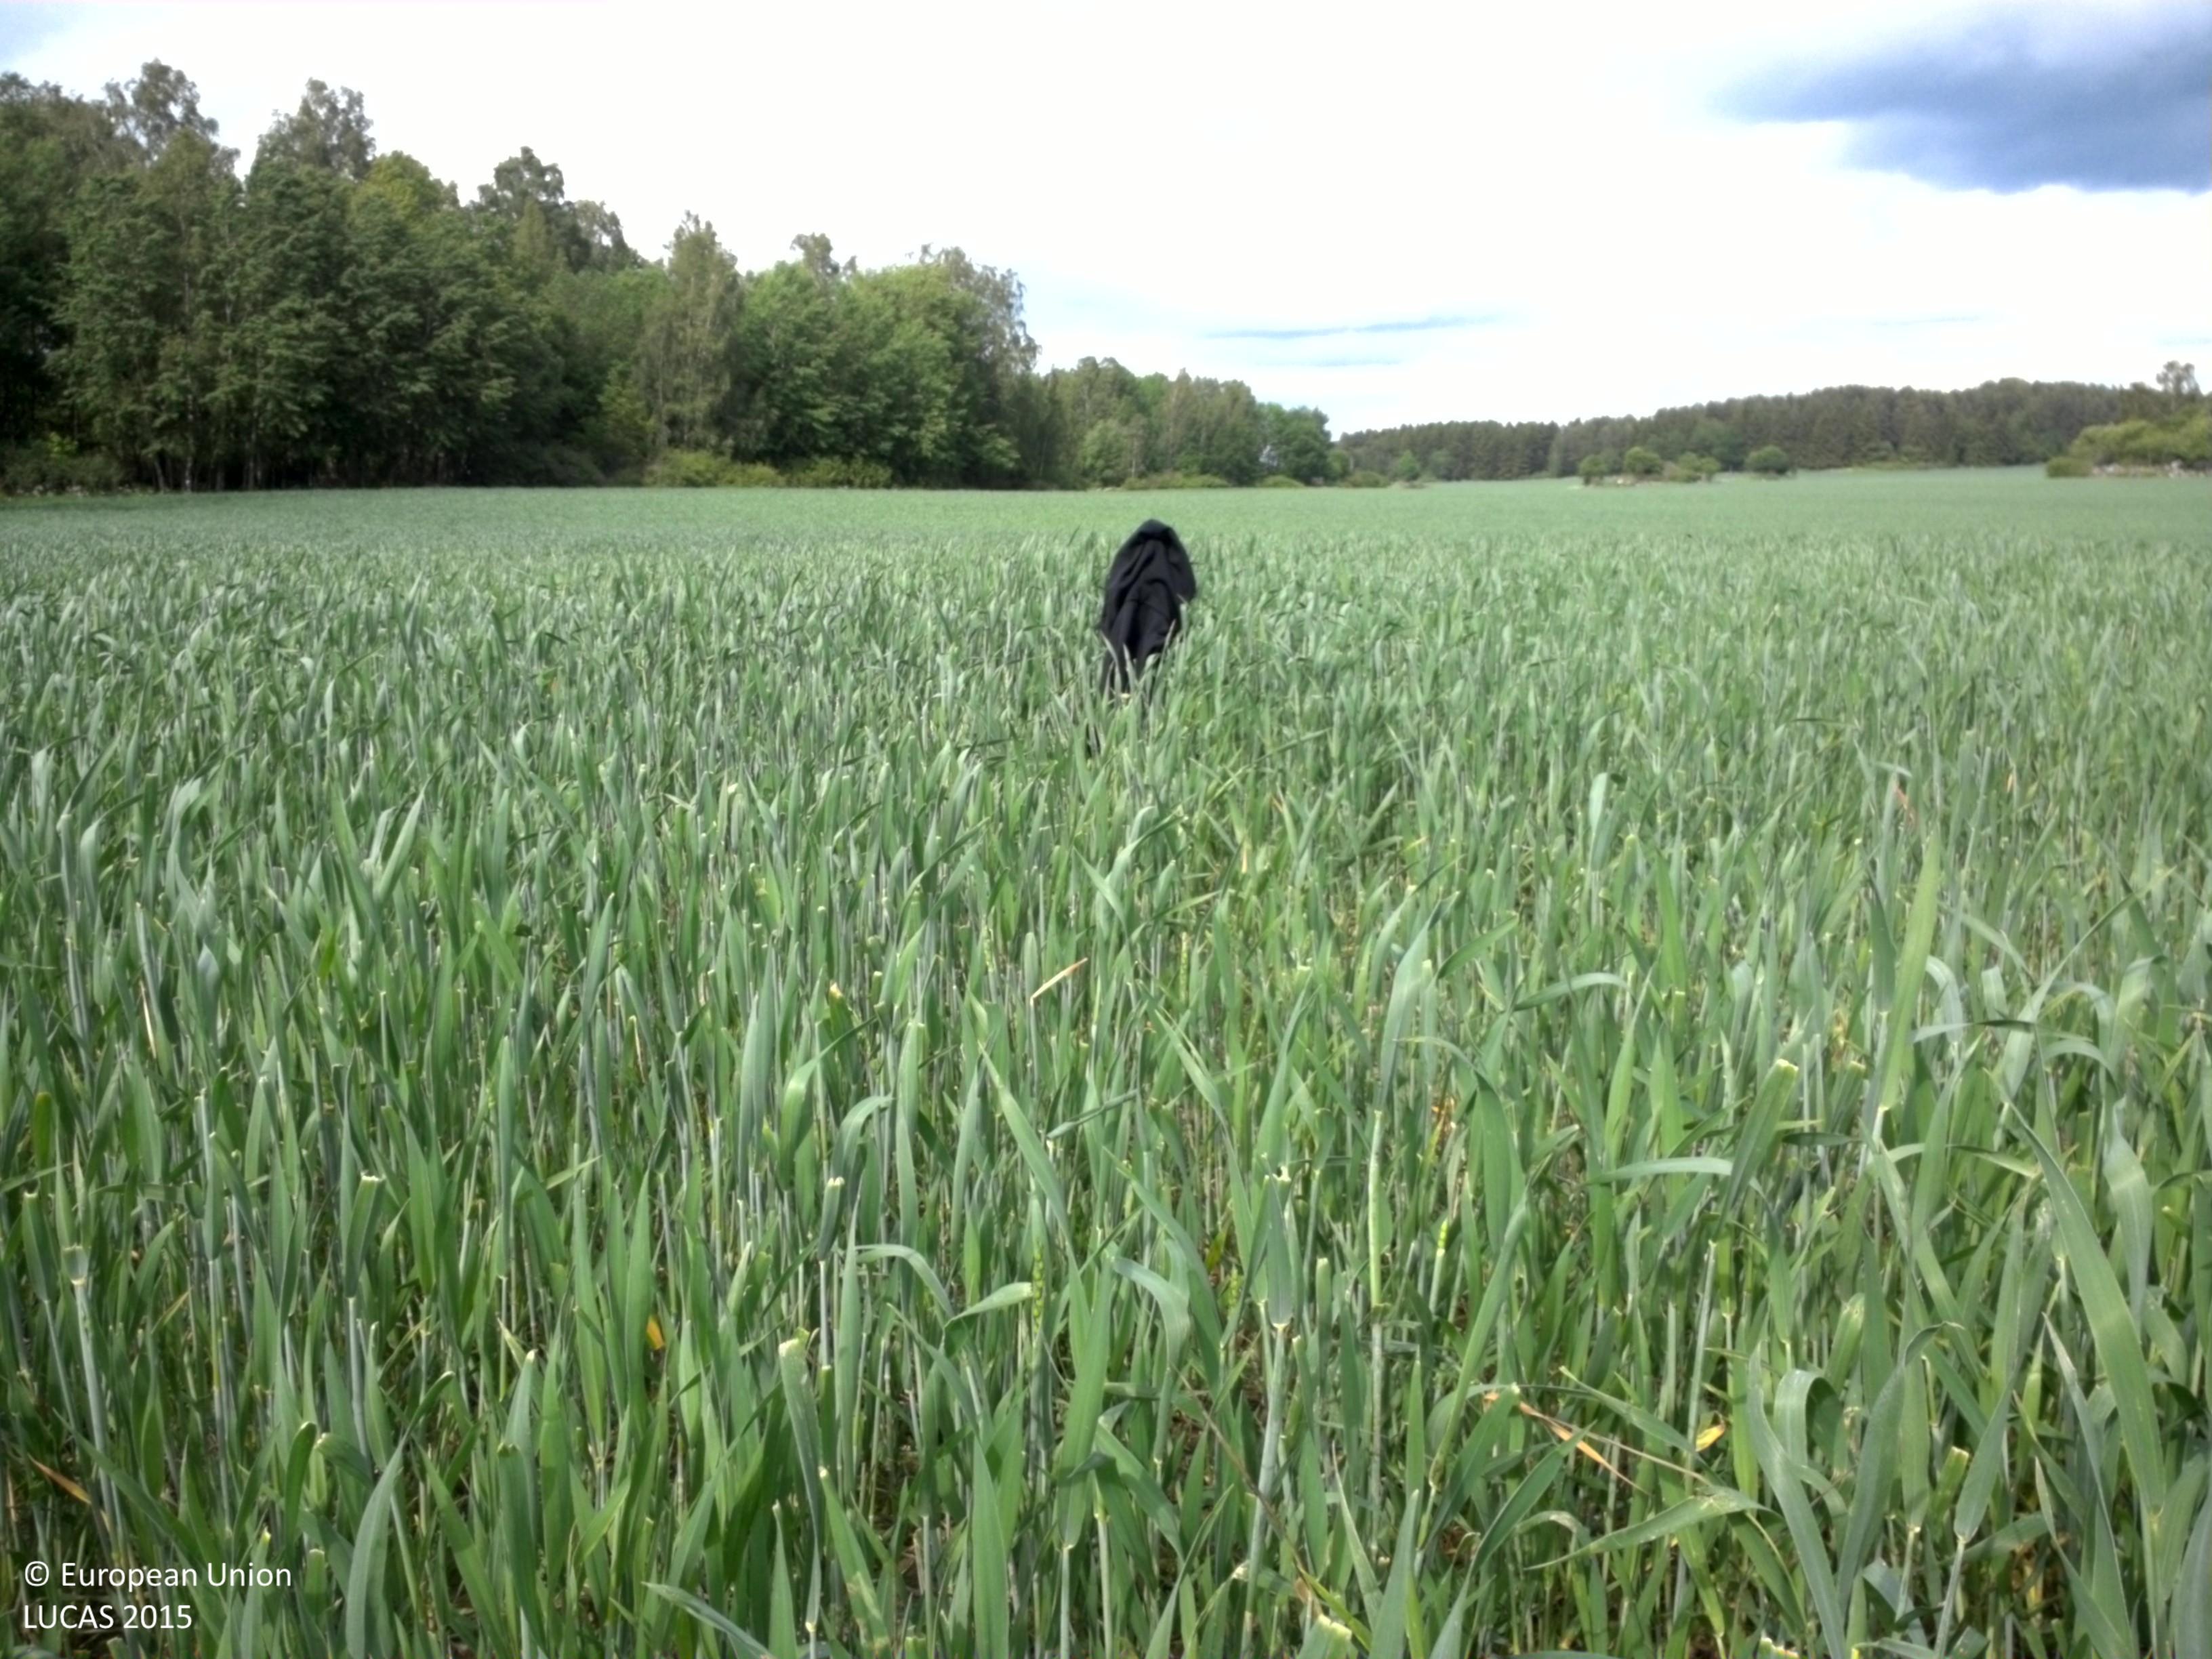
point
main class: Cropland
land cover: Common wheat
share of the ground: > 75 %
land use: Agriculture (excluding fallow land and kitchen gardens)
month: June
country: SE
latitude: 59.5737
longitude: 16.9861
